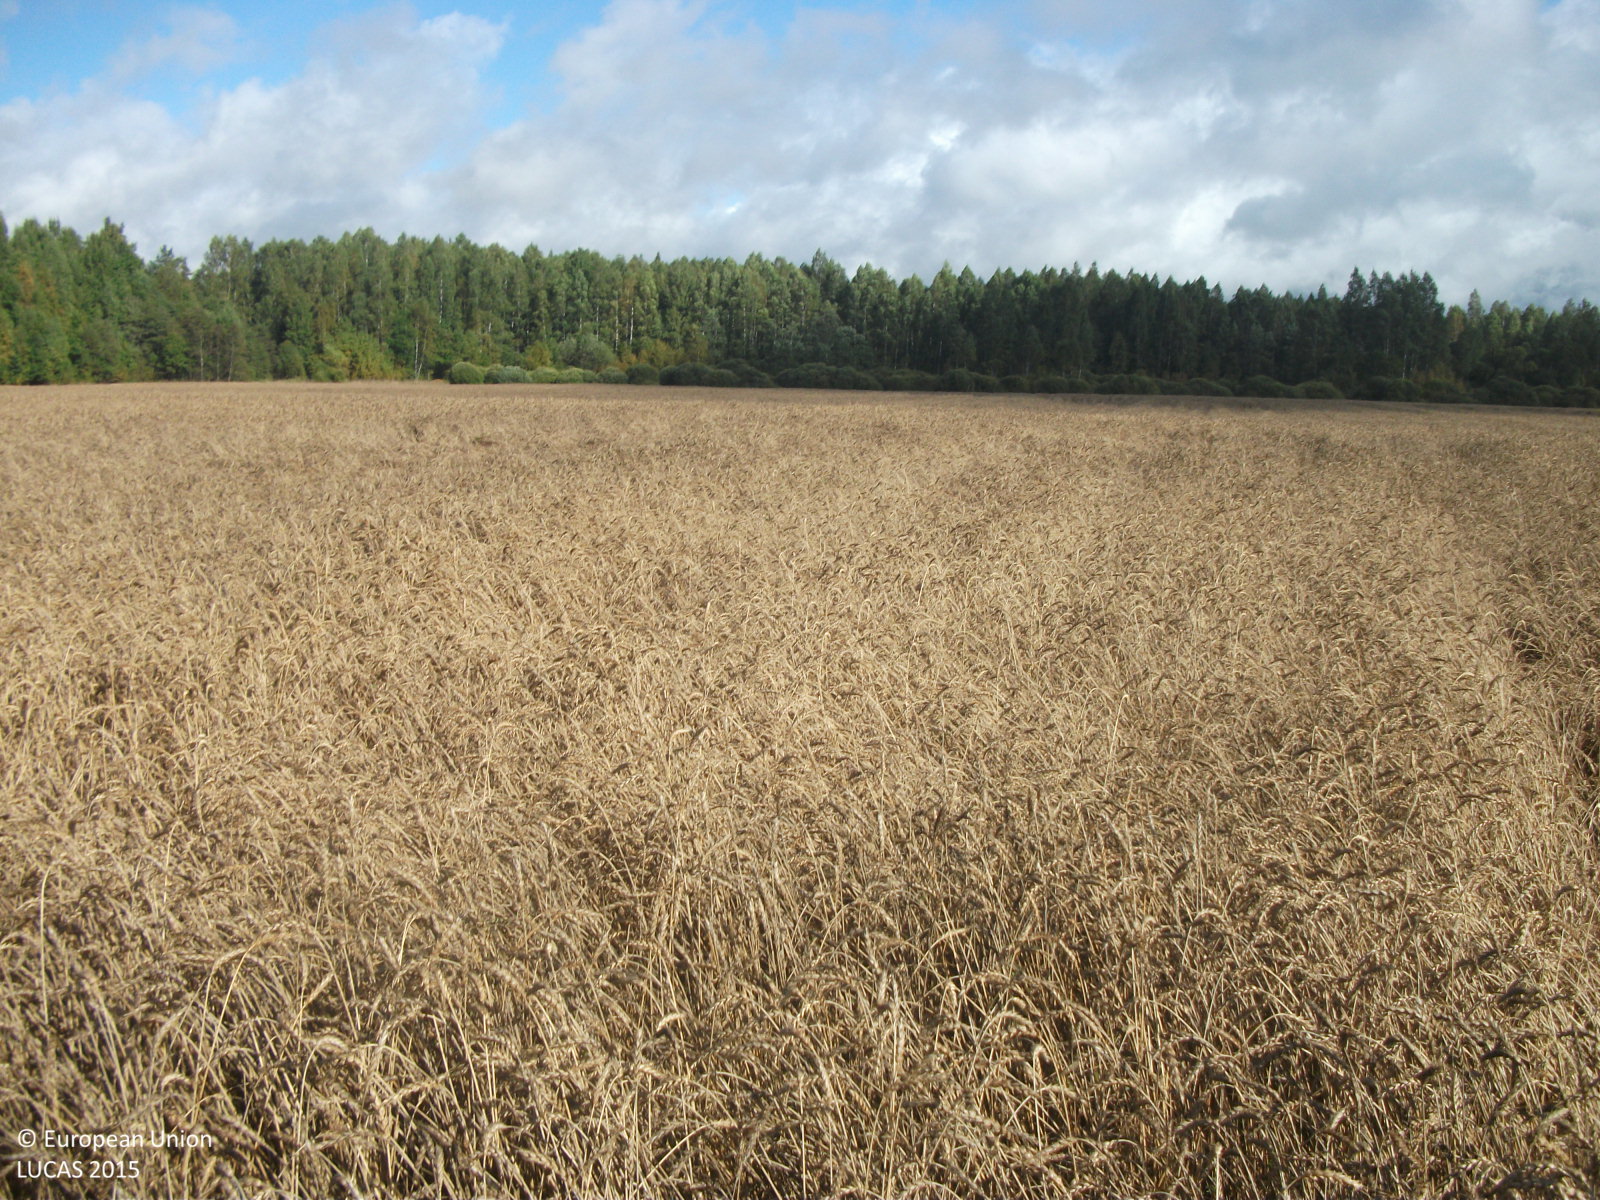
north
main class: Cropland
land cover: Common wheat
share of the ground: > 75 %
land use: Agriculture (excluding fallow land and kitchen gardens)
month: September
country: LV
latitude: 57.7312
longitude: 24.8939
